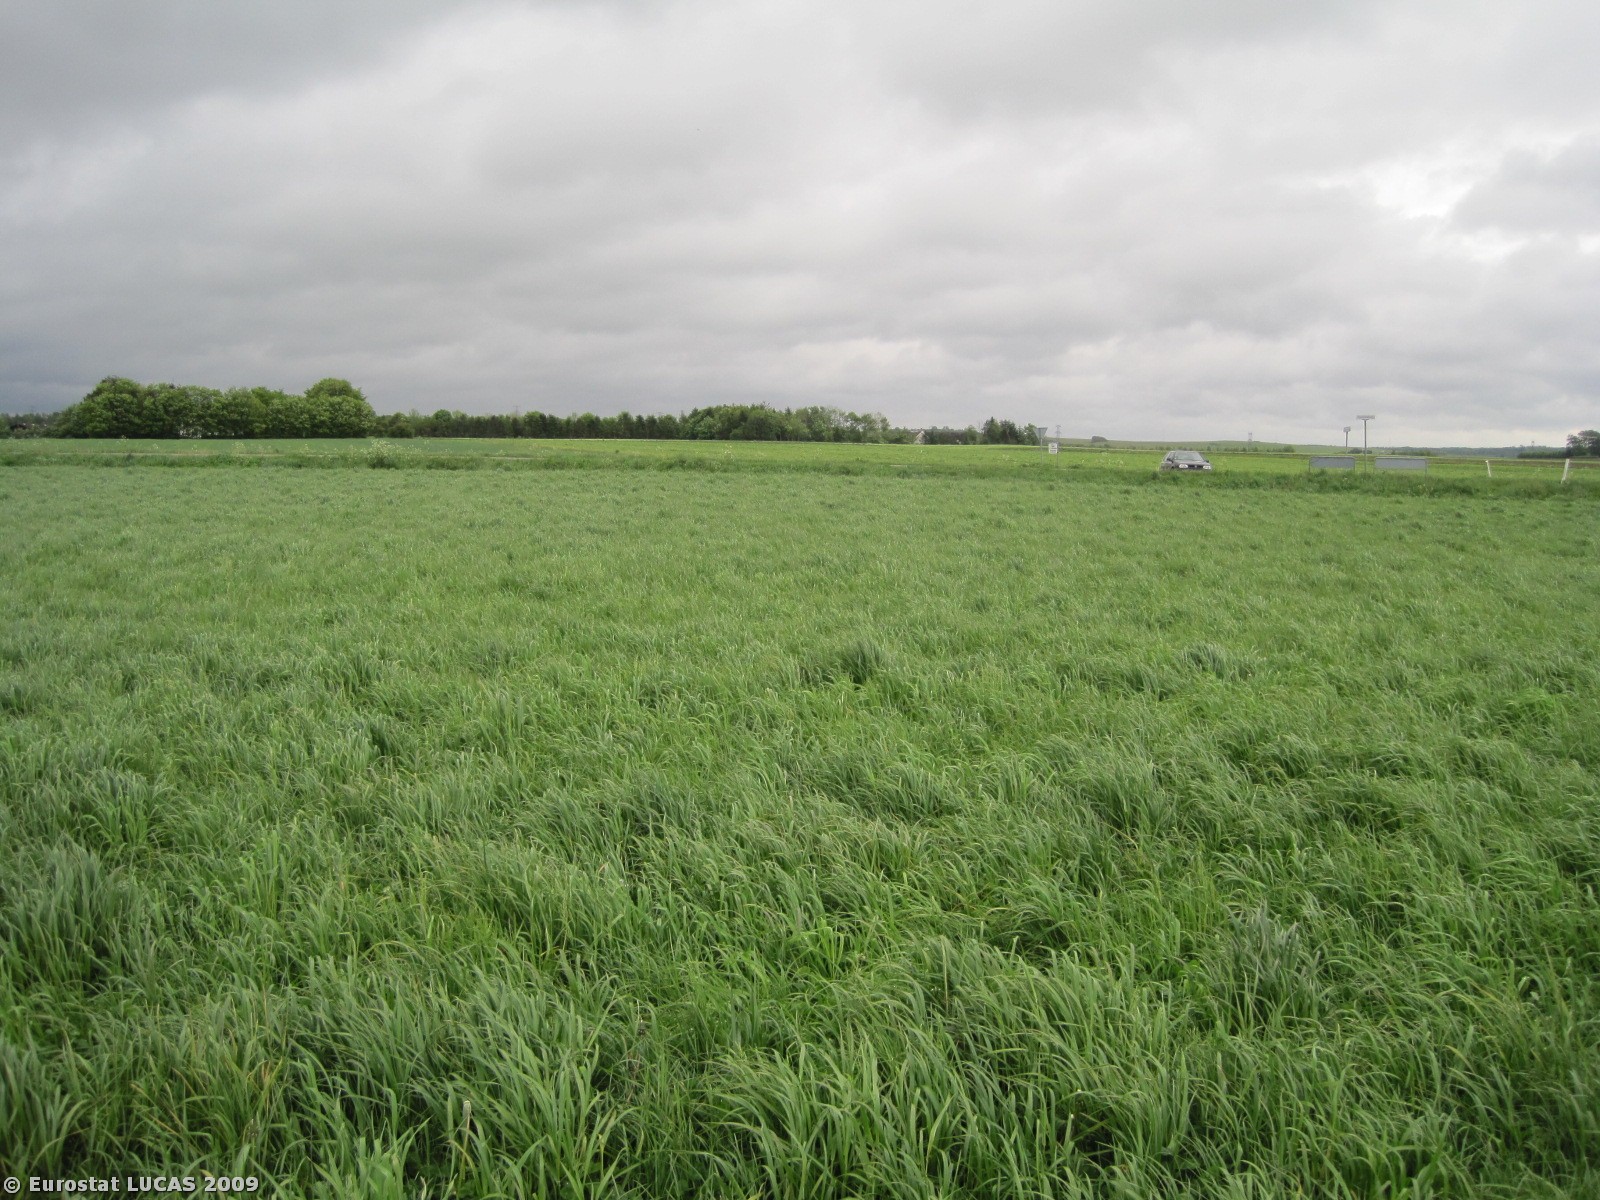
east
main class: Grassland
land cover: Grassland without tree/shrub cover
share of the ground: > 75 %
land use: Agriculture (excluding fallow land and kitchen gardens)
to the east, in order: Grassland without tree/shrub cover; Paved roads, cycling and walking lanes; Grassland without tree/shrub cover; Common wheat
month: May
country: DK
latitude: 56.8345
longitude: 9.6890
